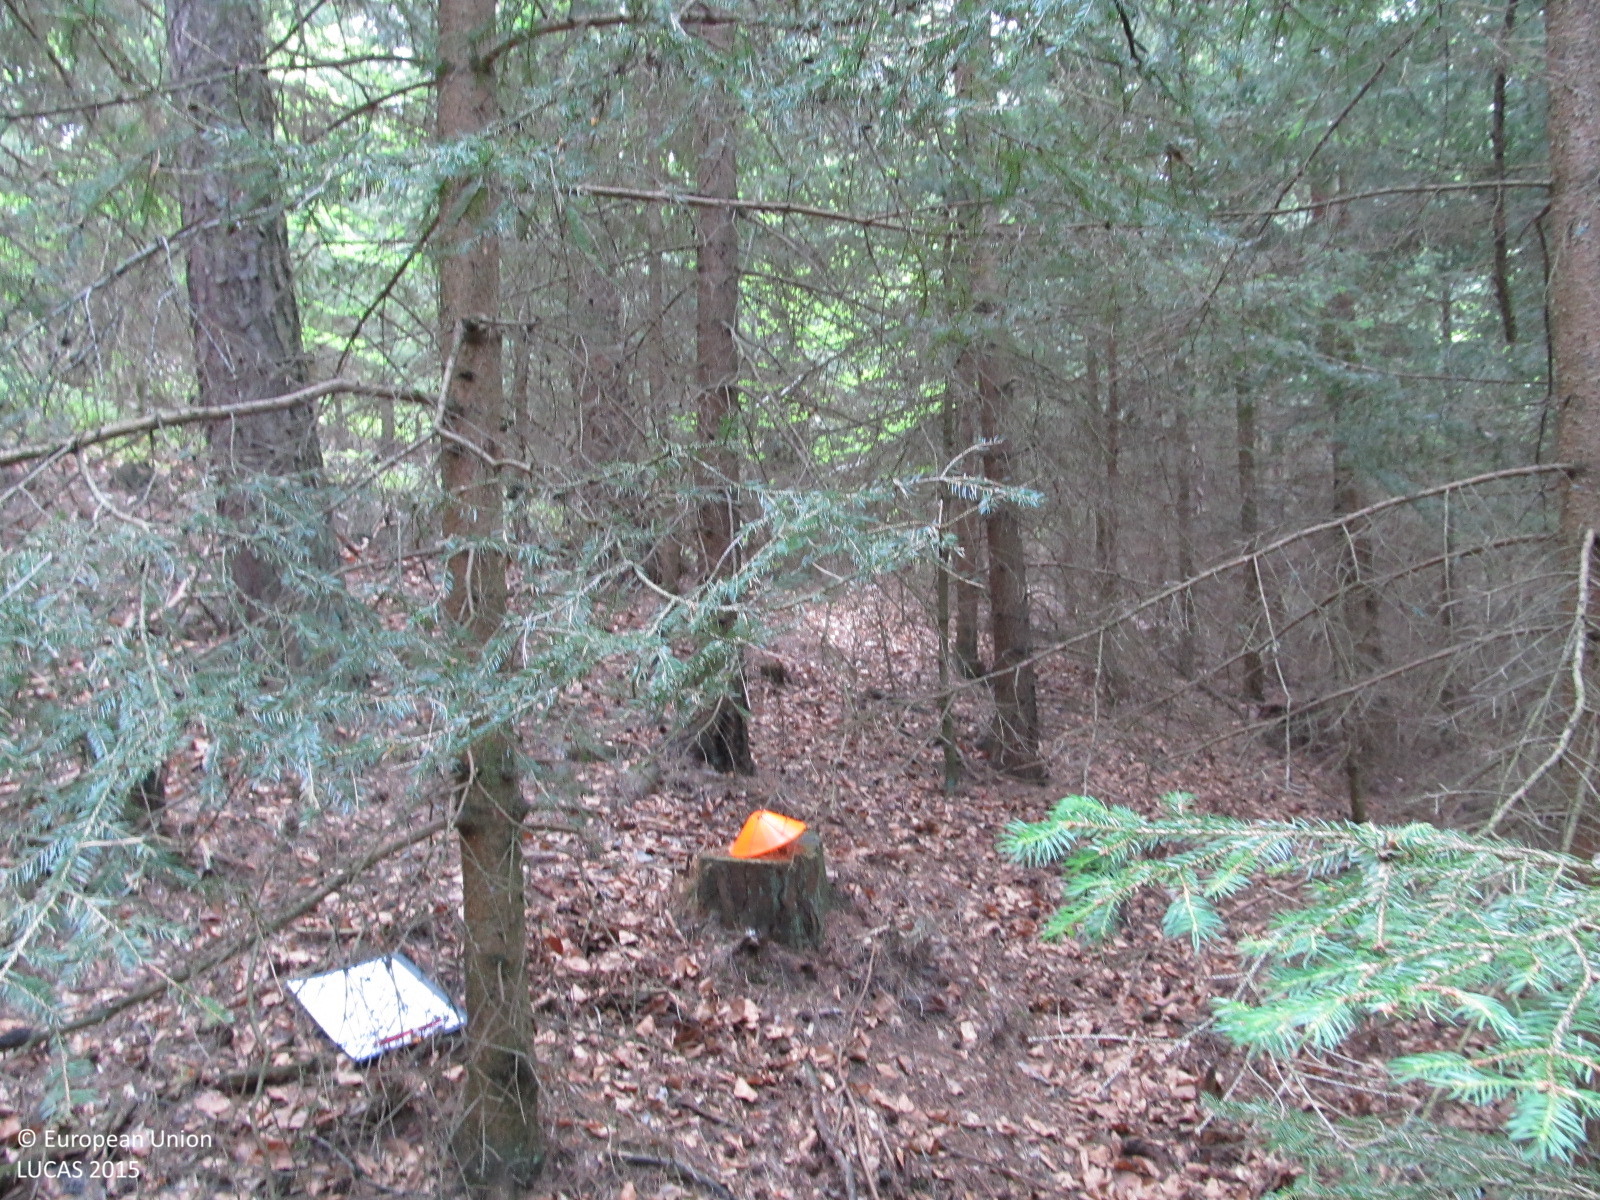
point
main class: Woodland
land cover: Spruce dominated coniferous woodland
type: hemiboreal forest and nemoral coniferous forest and mixed broadleaved-coniferous forest
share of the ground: > 75 %
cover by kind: coniferous forest trees 85 %, unconsolidated bare surface 10 %, broadleaved forest trees 5 %
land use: Forestry
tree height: > 5 m
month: June
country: AT
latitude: 48.4301
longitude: 15.4762
